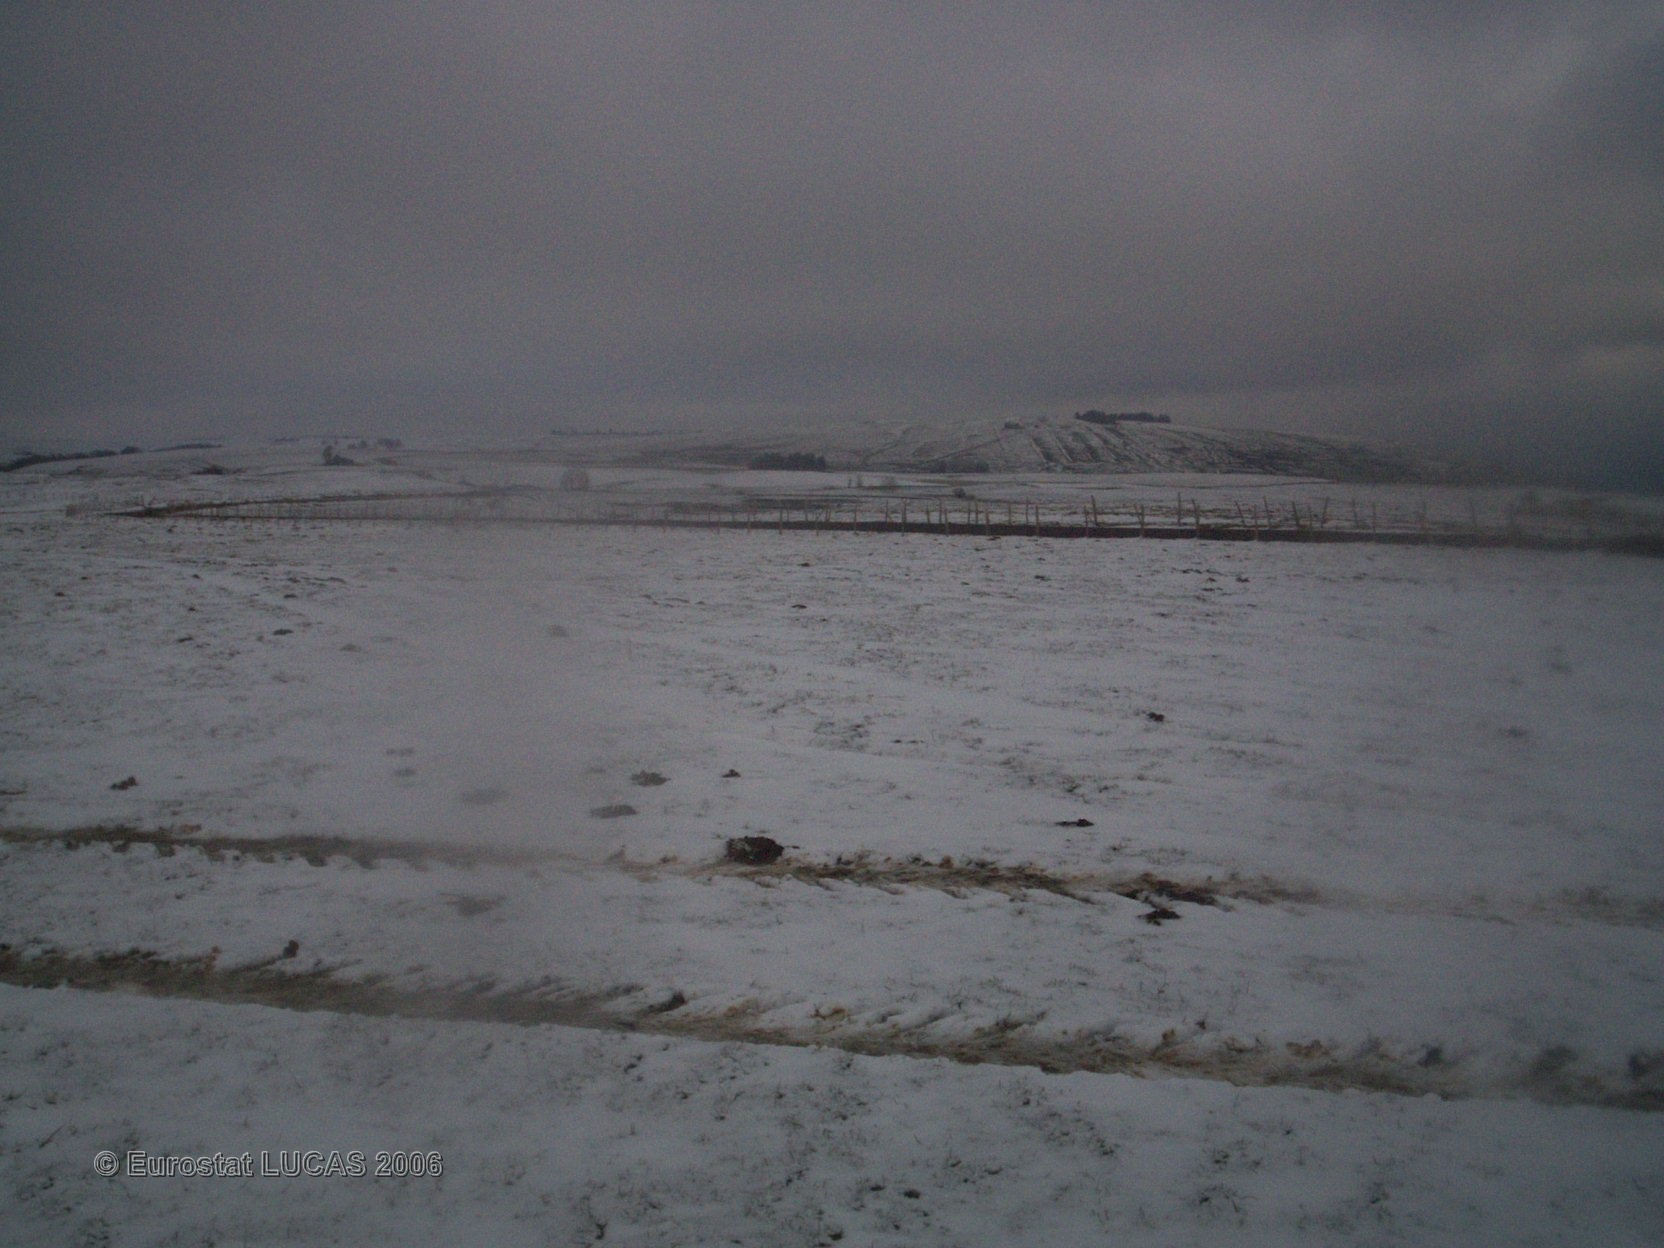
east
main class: Grassland
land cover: Grassland without tree/shrub cover
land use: Agriculture (excluding fallow land and kitchen gardens)
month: April
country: FR
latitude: 45.4156
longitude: 2.9851
